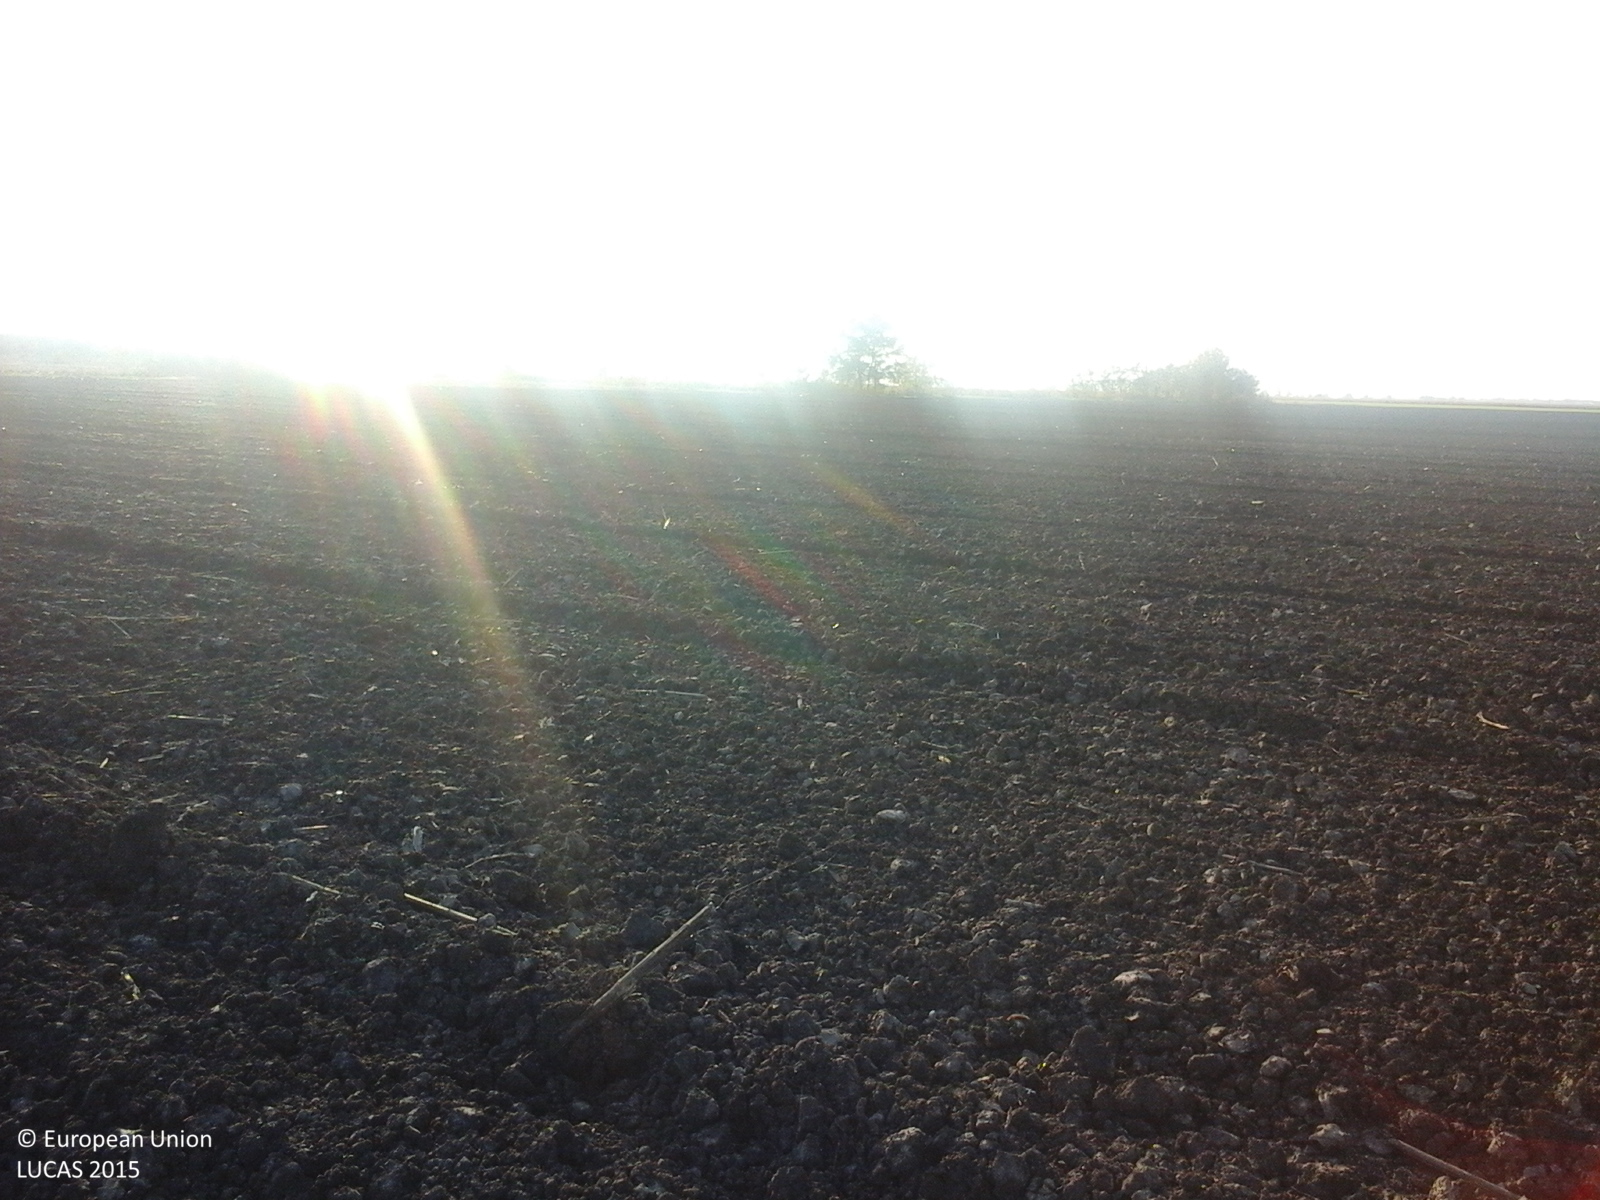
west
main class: Cropland
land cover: Sunflower
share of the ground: < 10 %
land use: Agriculture (excluding fallow land and kitchen gardens)
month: October
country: RO
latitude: 45.2018
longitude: 26.9782
